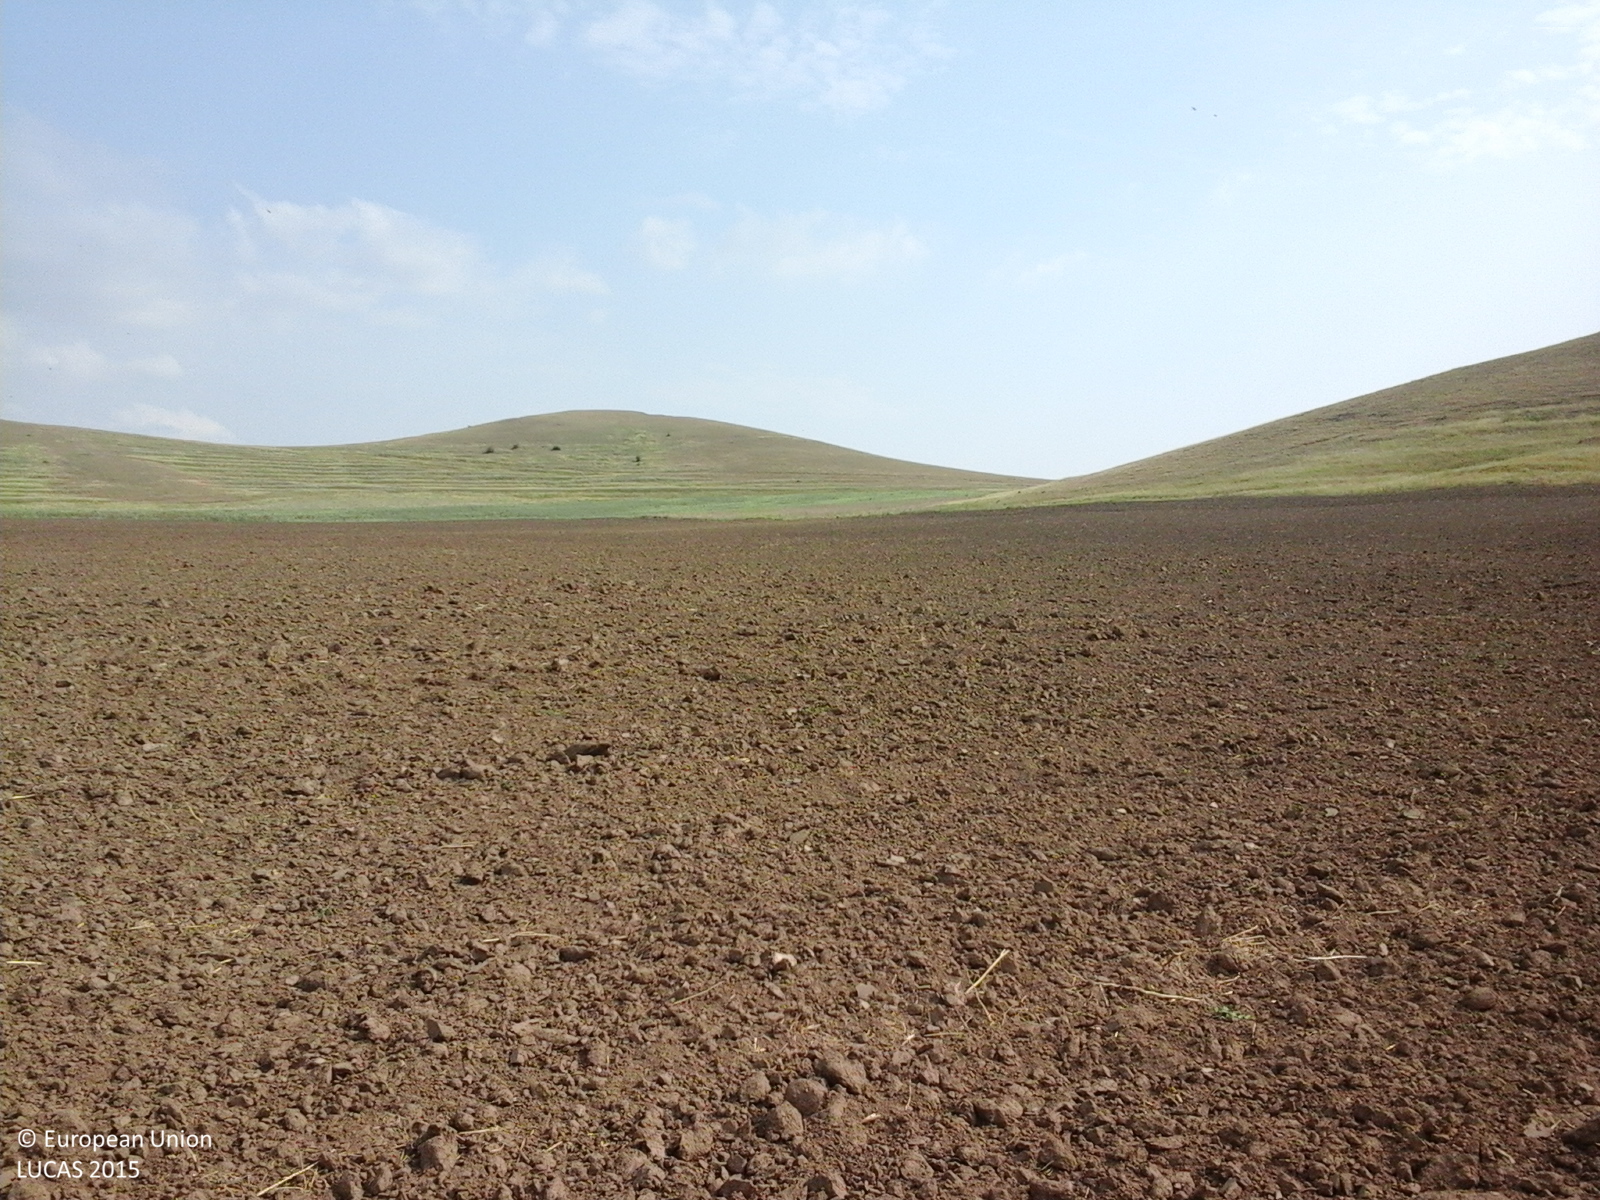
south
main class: Cropland
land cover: Rape and turnip rape
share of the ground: < 10 %
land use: Agriculture (excluding fallow land and kitchen gardens)
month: July
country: RO
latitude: 45.1168
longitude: 28.2356
